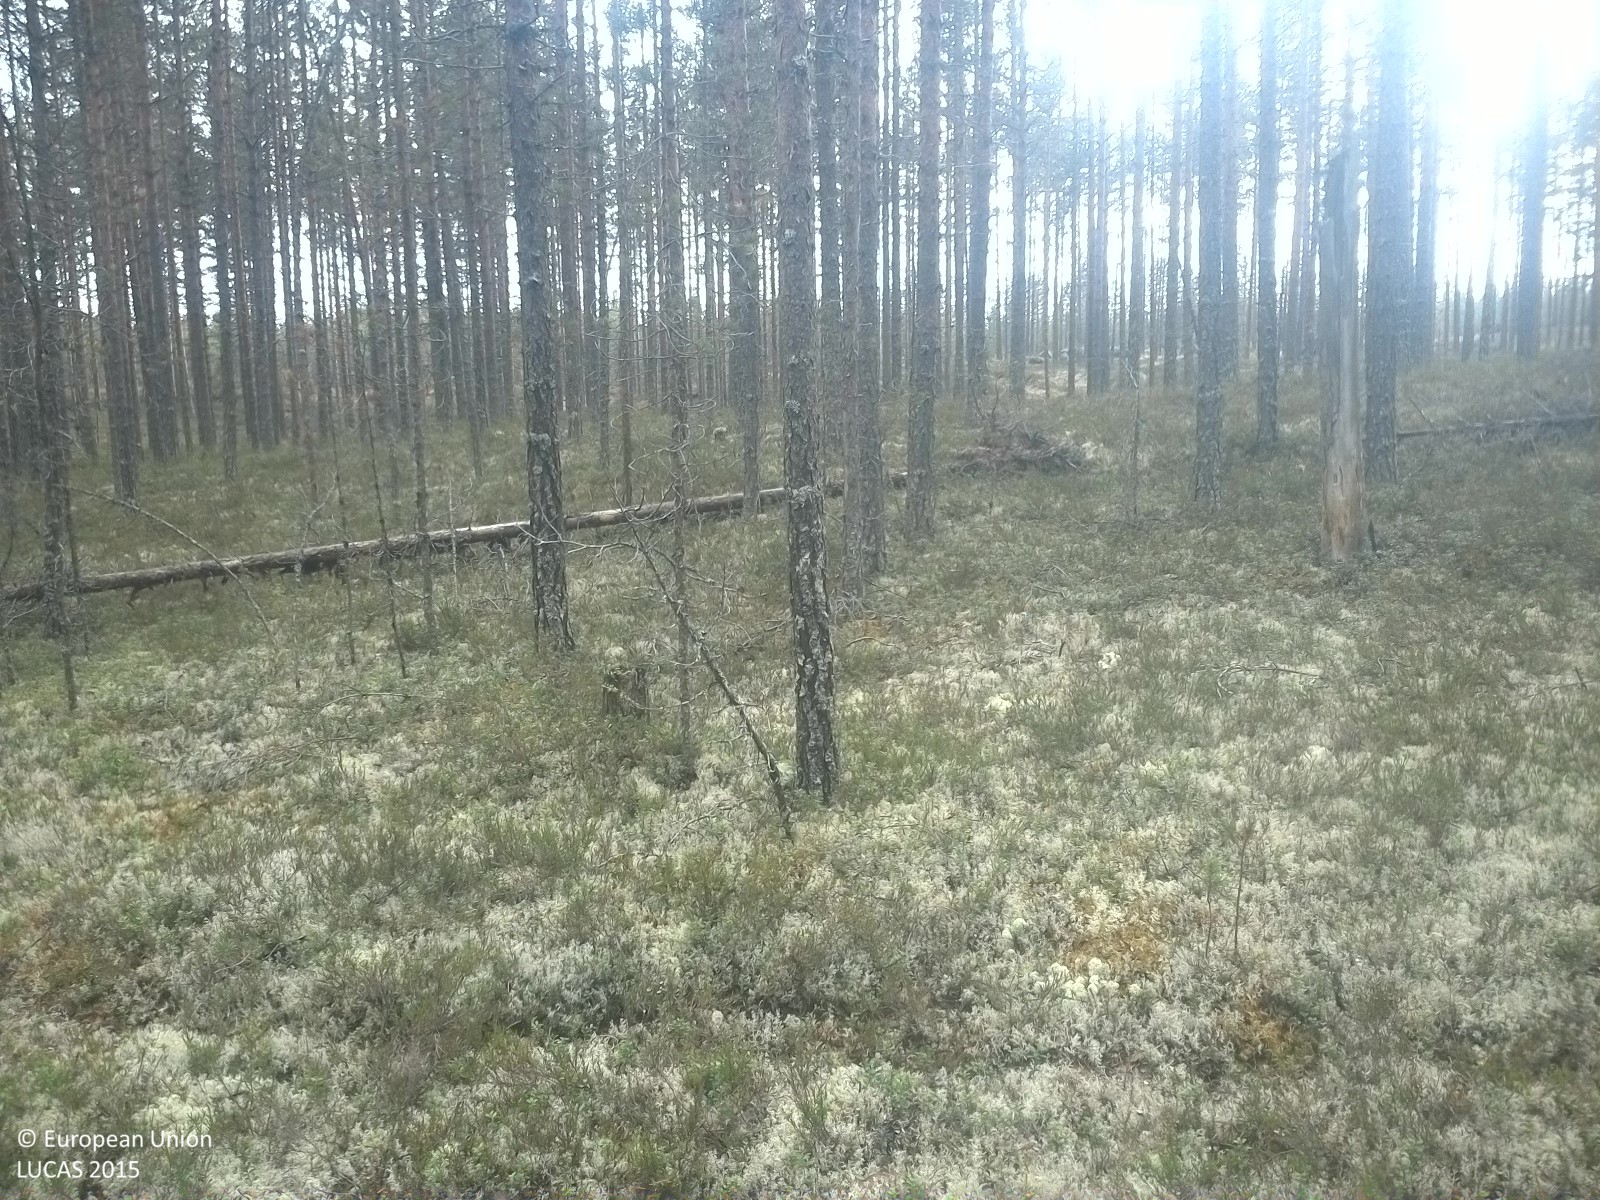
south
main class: Woodland
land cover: Pine dominated coniferous woodland
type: boreal forest
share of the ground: 50 - 75 %
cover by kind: coniferous forest trees 50 %, lichens and mosses 40 %, shrubs 10 %
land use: Forestry
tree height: > 5 m
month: September
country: SE
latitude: 62.2033
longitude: 15.5361
